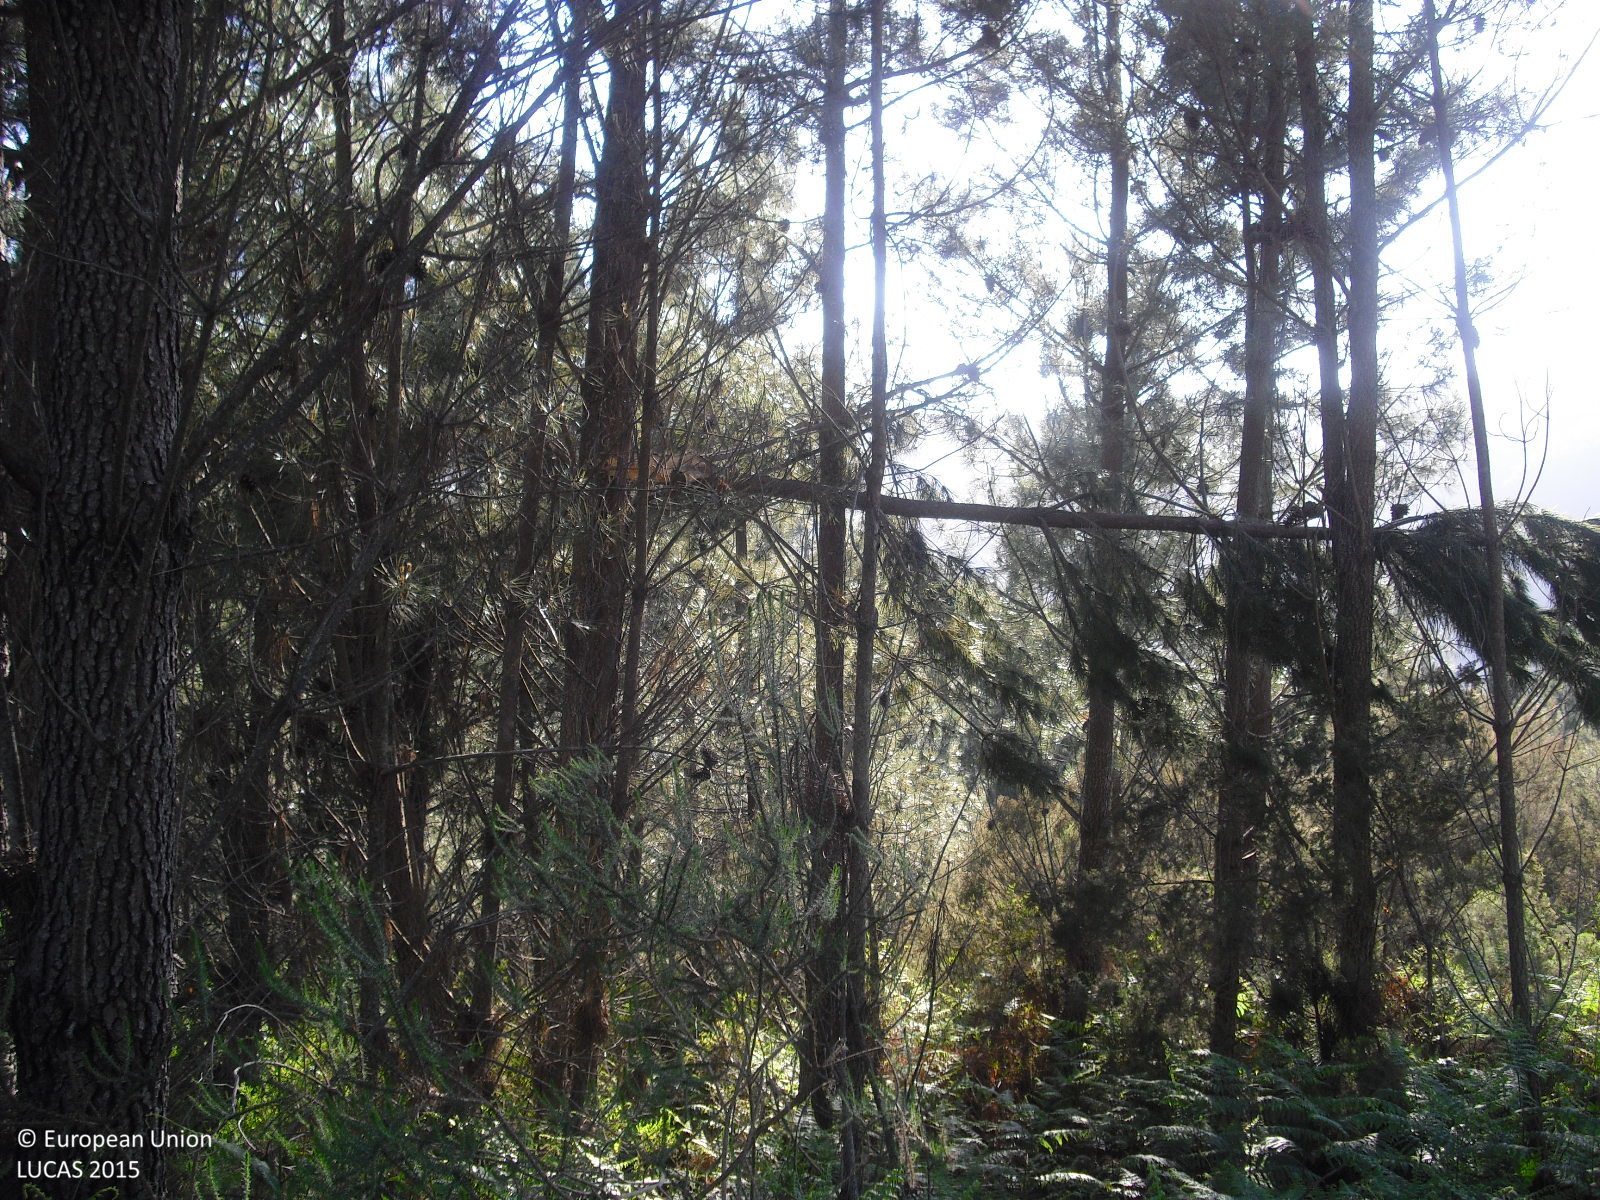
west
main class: Woodland
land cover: Pine dominated coniferous woodland
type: hemiboreal forest and nemoral coniferous forest and mixed broadleaved-coniferous forest
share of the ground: 25 - 50 %
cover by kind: coniferous forest trees 50 %, shrubs 50 %
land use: Forestry
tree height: > 5 m
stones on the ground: 25 - 50 %
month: May
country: ES
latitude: 41.8942
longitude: -8.1958
